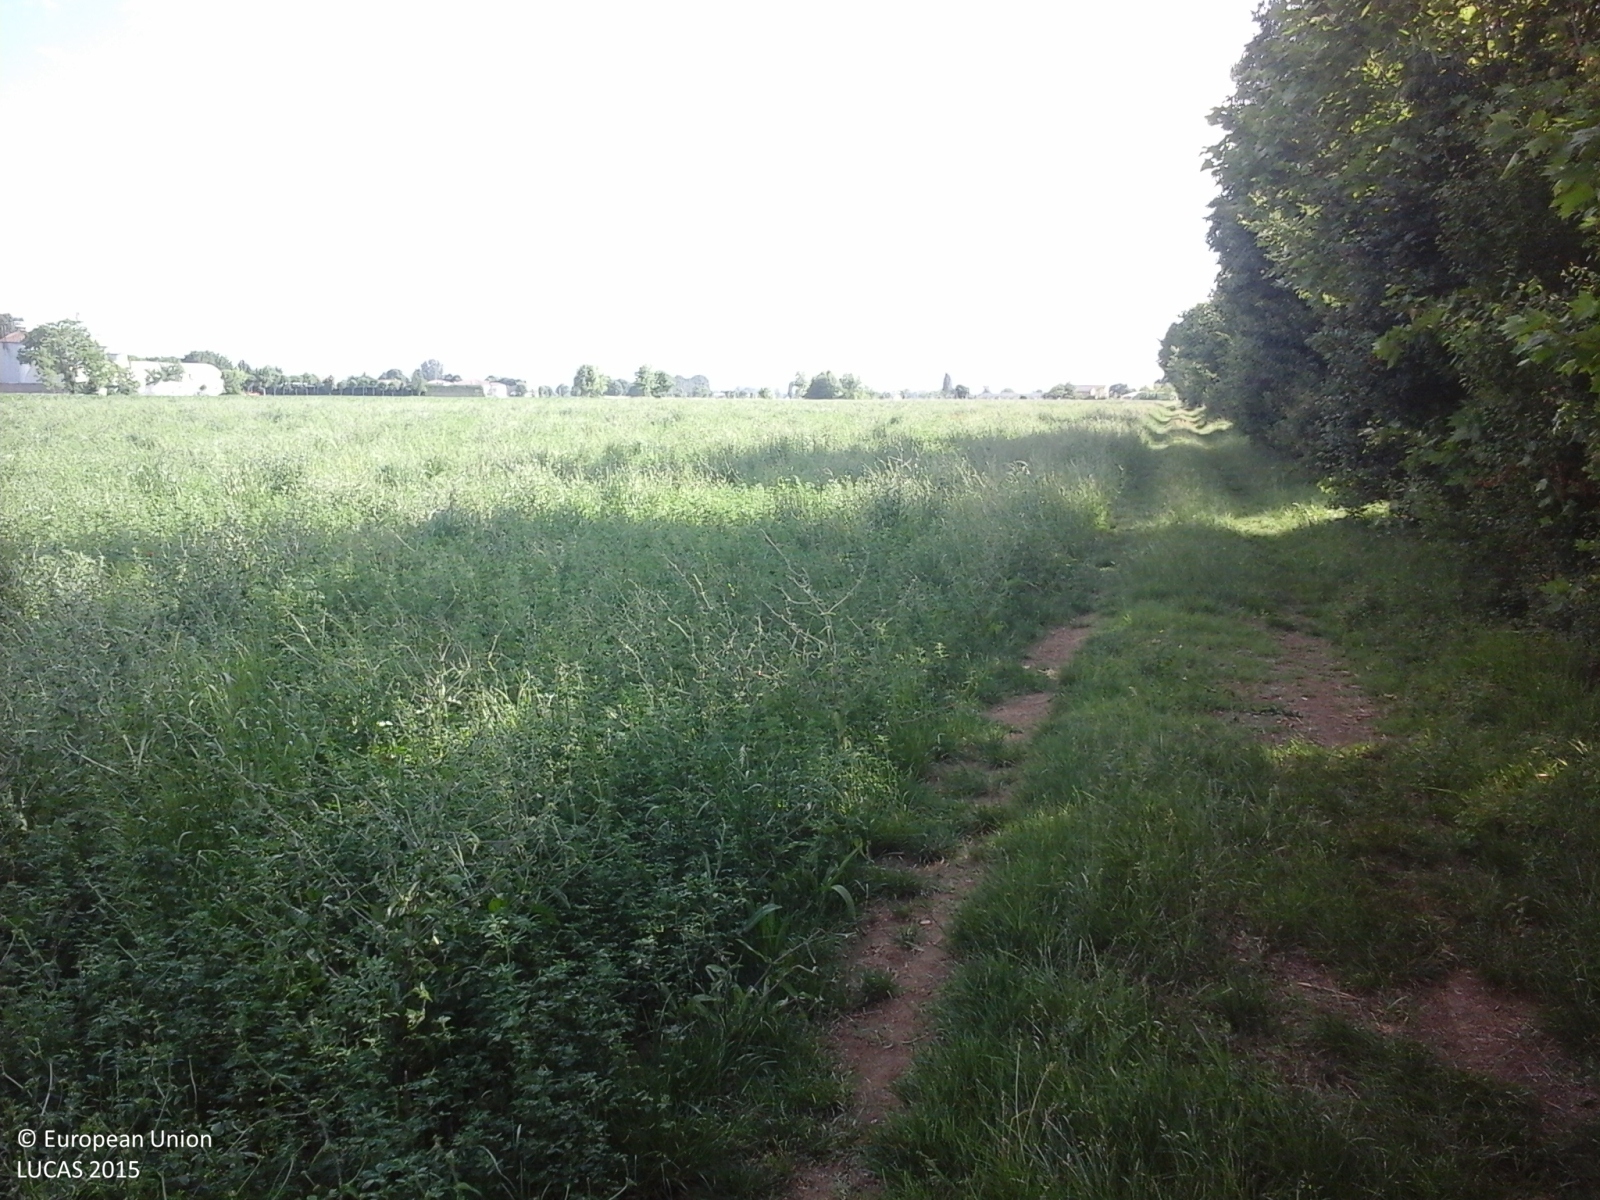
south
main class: Cropland
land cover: Lucerne
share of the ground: > 75 %
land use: Agriculture (excluding fallow land and kitchen gardens)
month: May
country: IT
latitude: 45.1048
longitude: 10.7991
